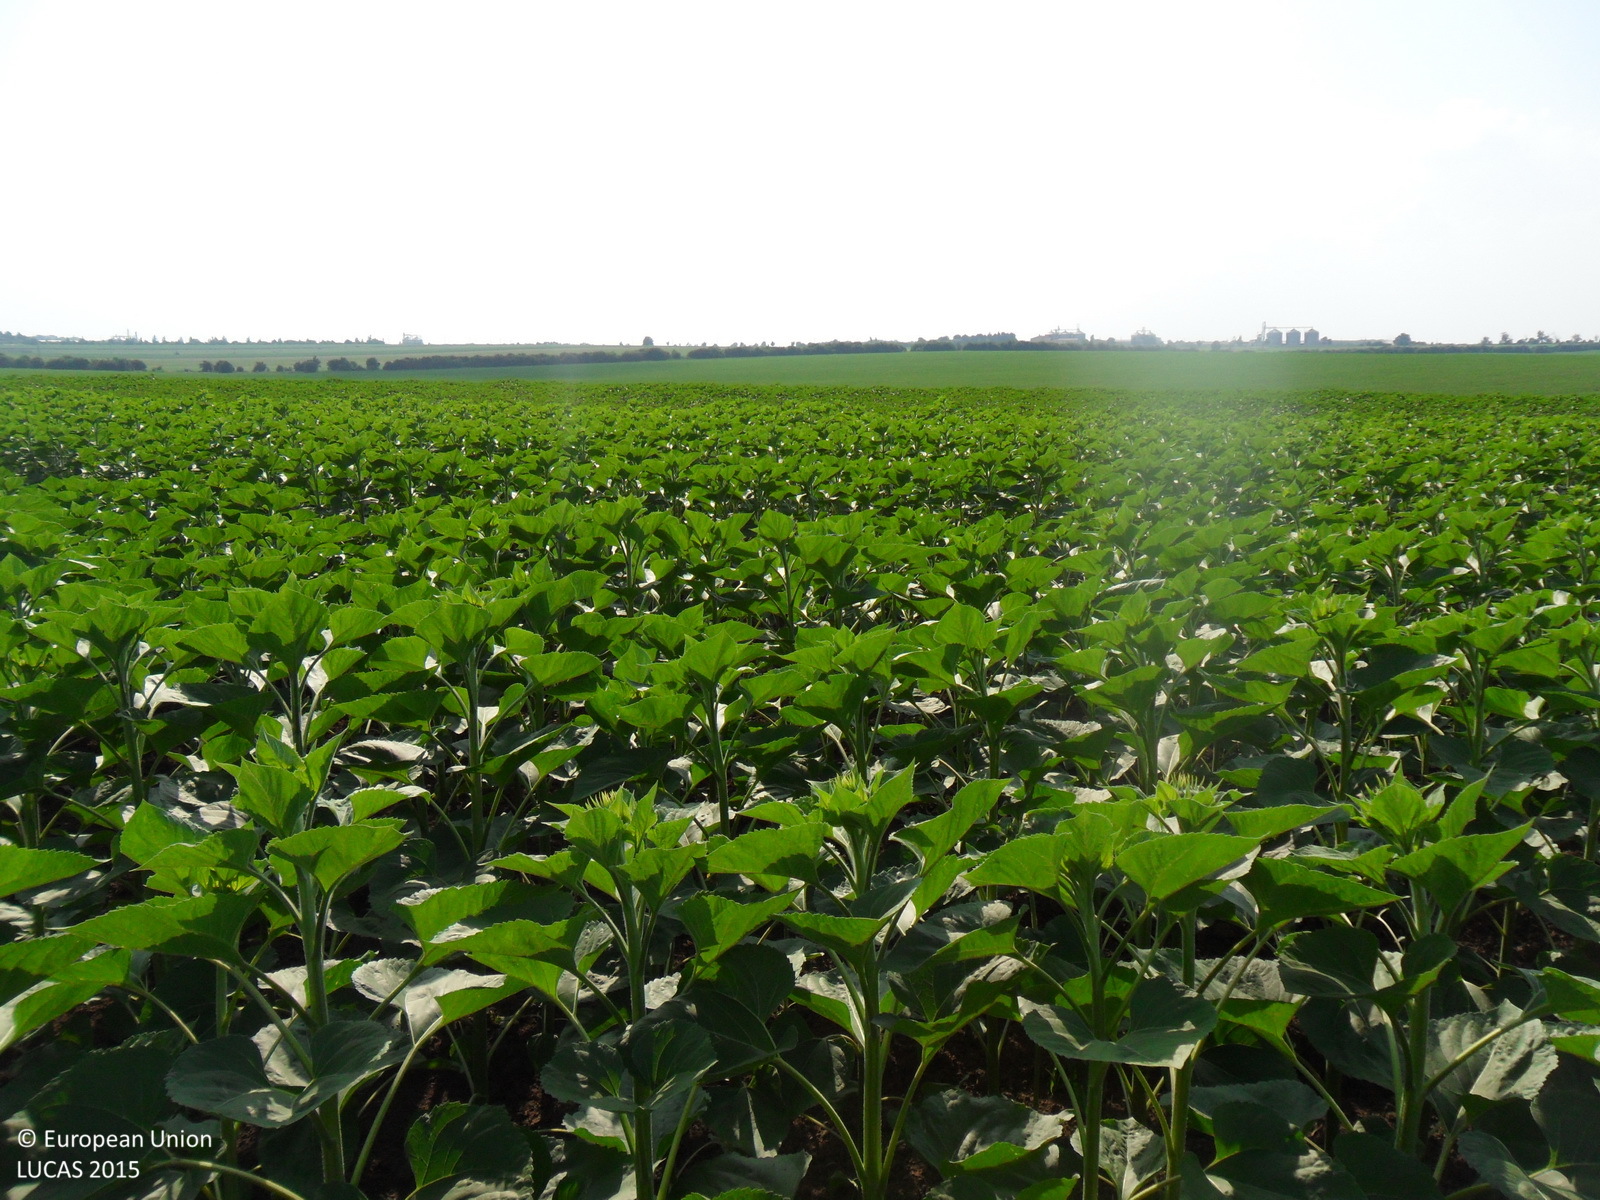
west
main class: Cropland
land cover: Sunflower
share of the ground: > 75 %
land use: Agriculture (excluding fallow land and kitchen gardens)
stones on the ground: < 10 %
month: June
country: BG
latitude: 43.7308
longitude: 26.8642
